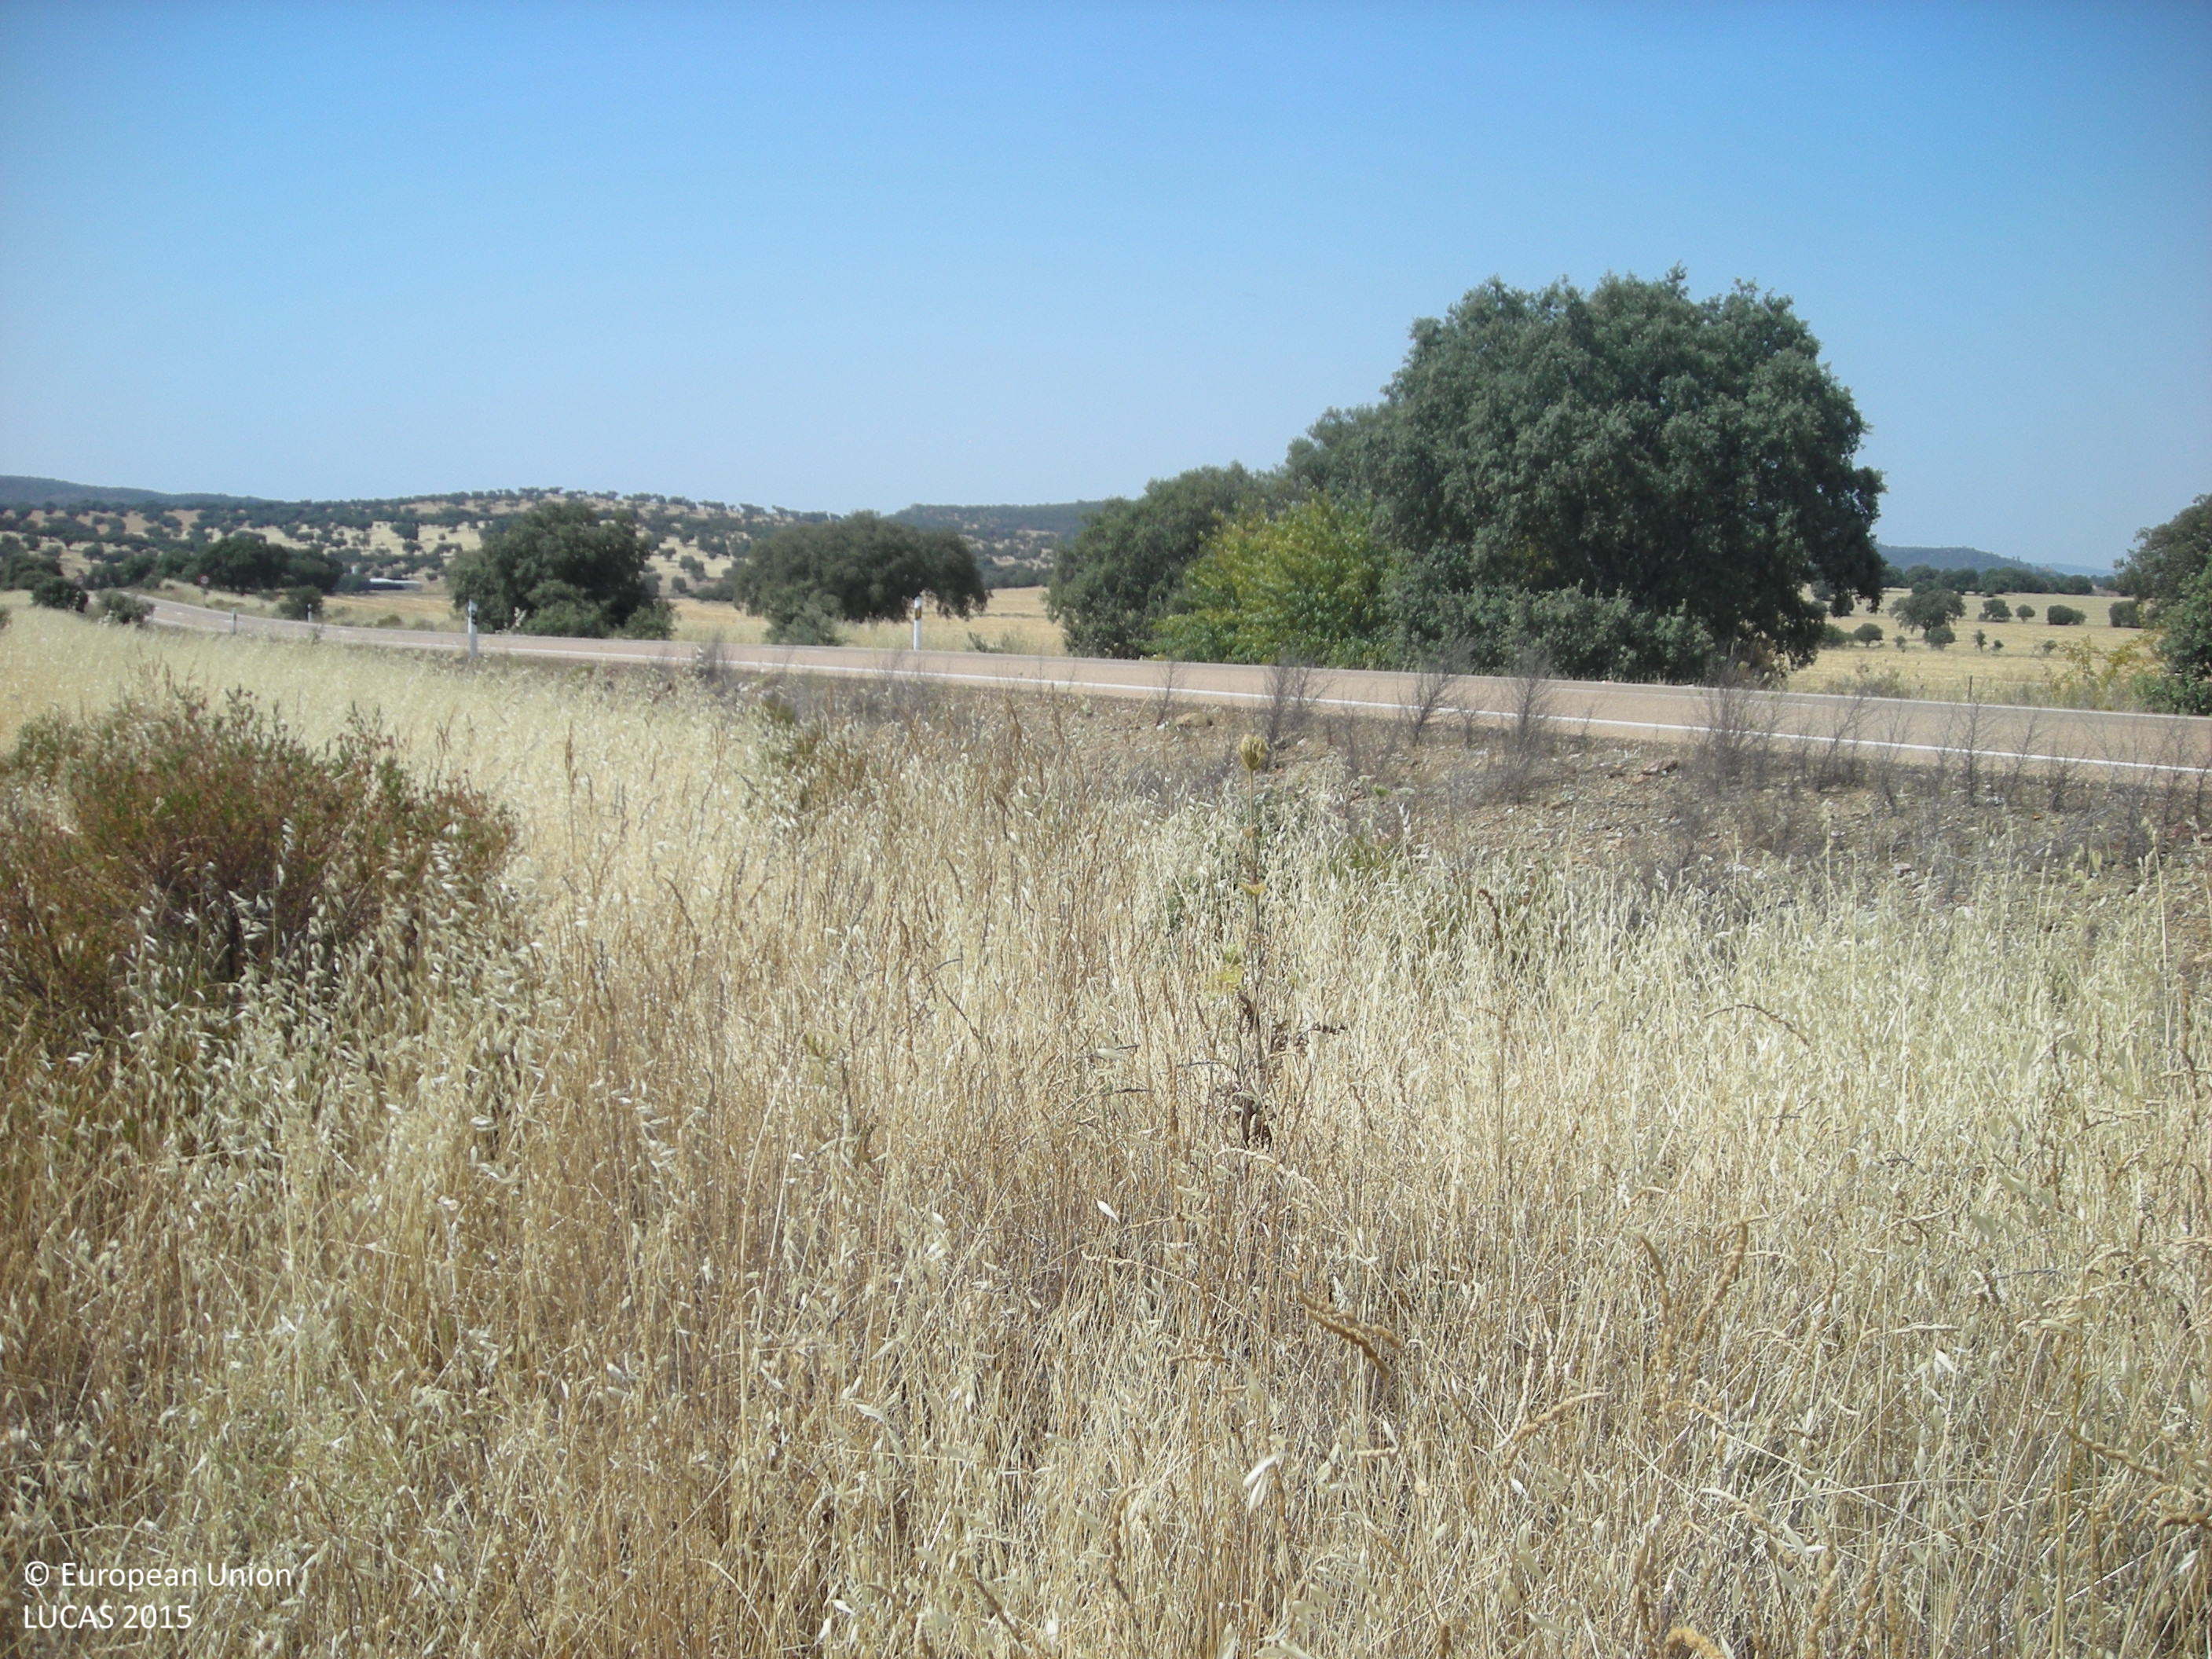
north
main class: Grassland
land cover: Grassland without tree/shrub cover
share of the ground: > 75 %
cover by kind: herbaceous plants 100 %
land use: Agriculture (excluding fallow land and kitchen gardens)
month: June
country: ES
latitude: 38.6148
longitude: -5.8812
